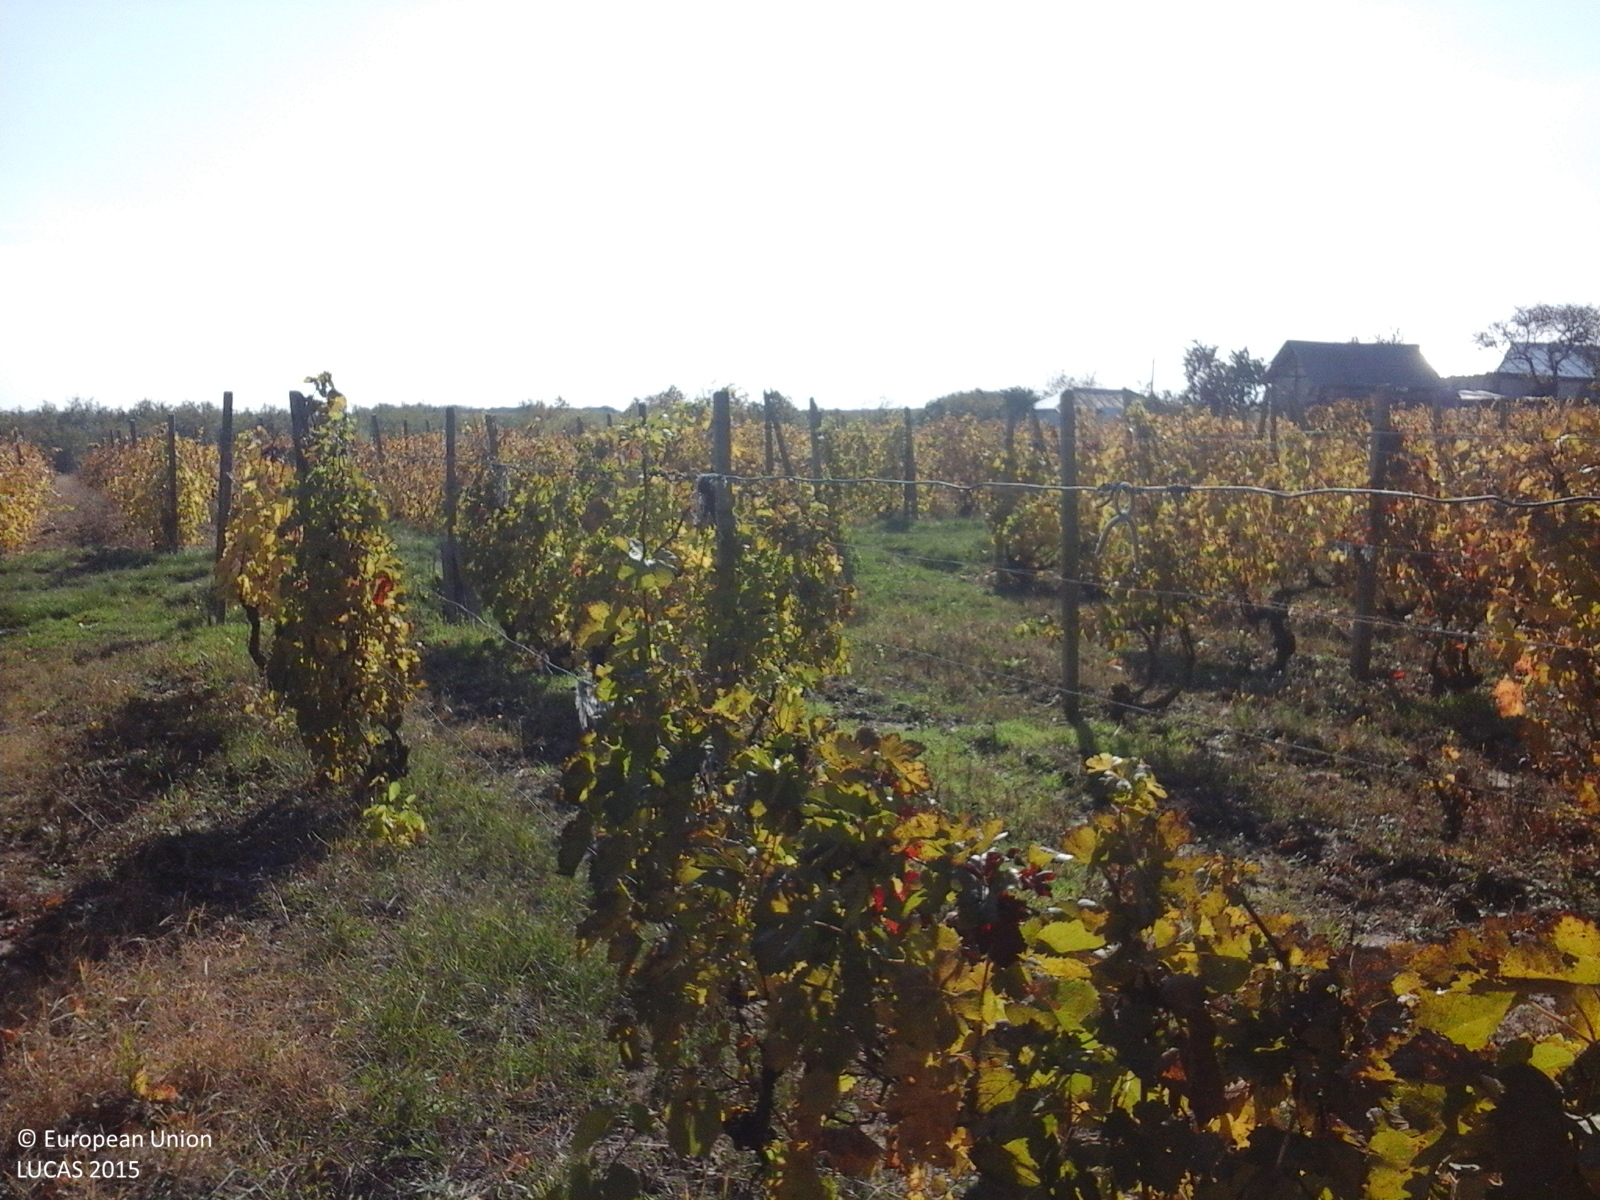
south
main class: Cropland
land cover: Vineyards
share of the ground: > 75 %
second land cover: Grassland without tree/shrub cover
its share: > 75 %
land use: Agriculture (excluding fallow land and kitchen gardens)
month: October
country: RO
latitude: 45.6646
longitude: 27.0722
